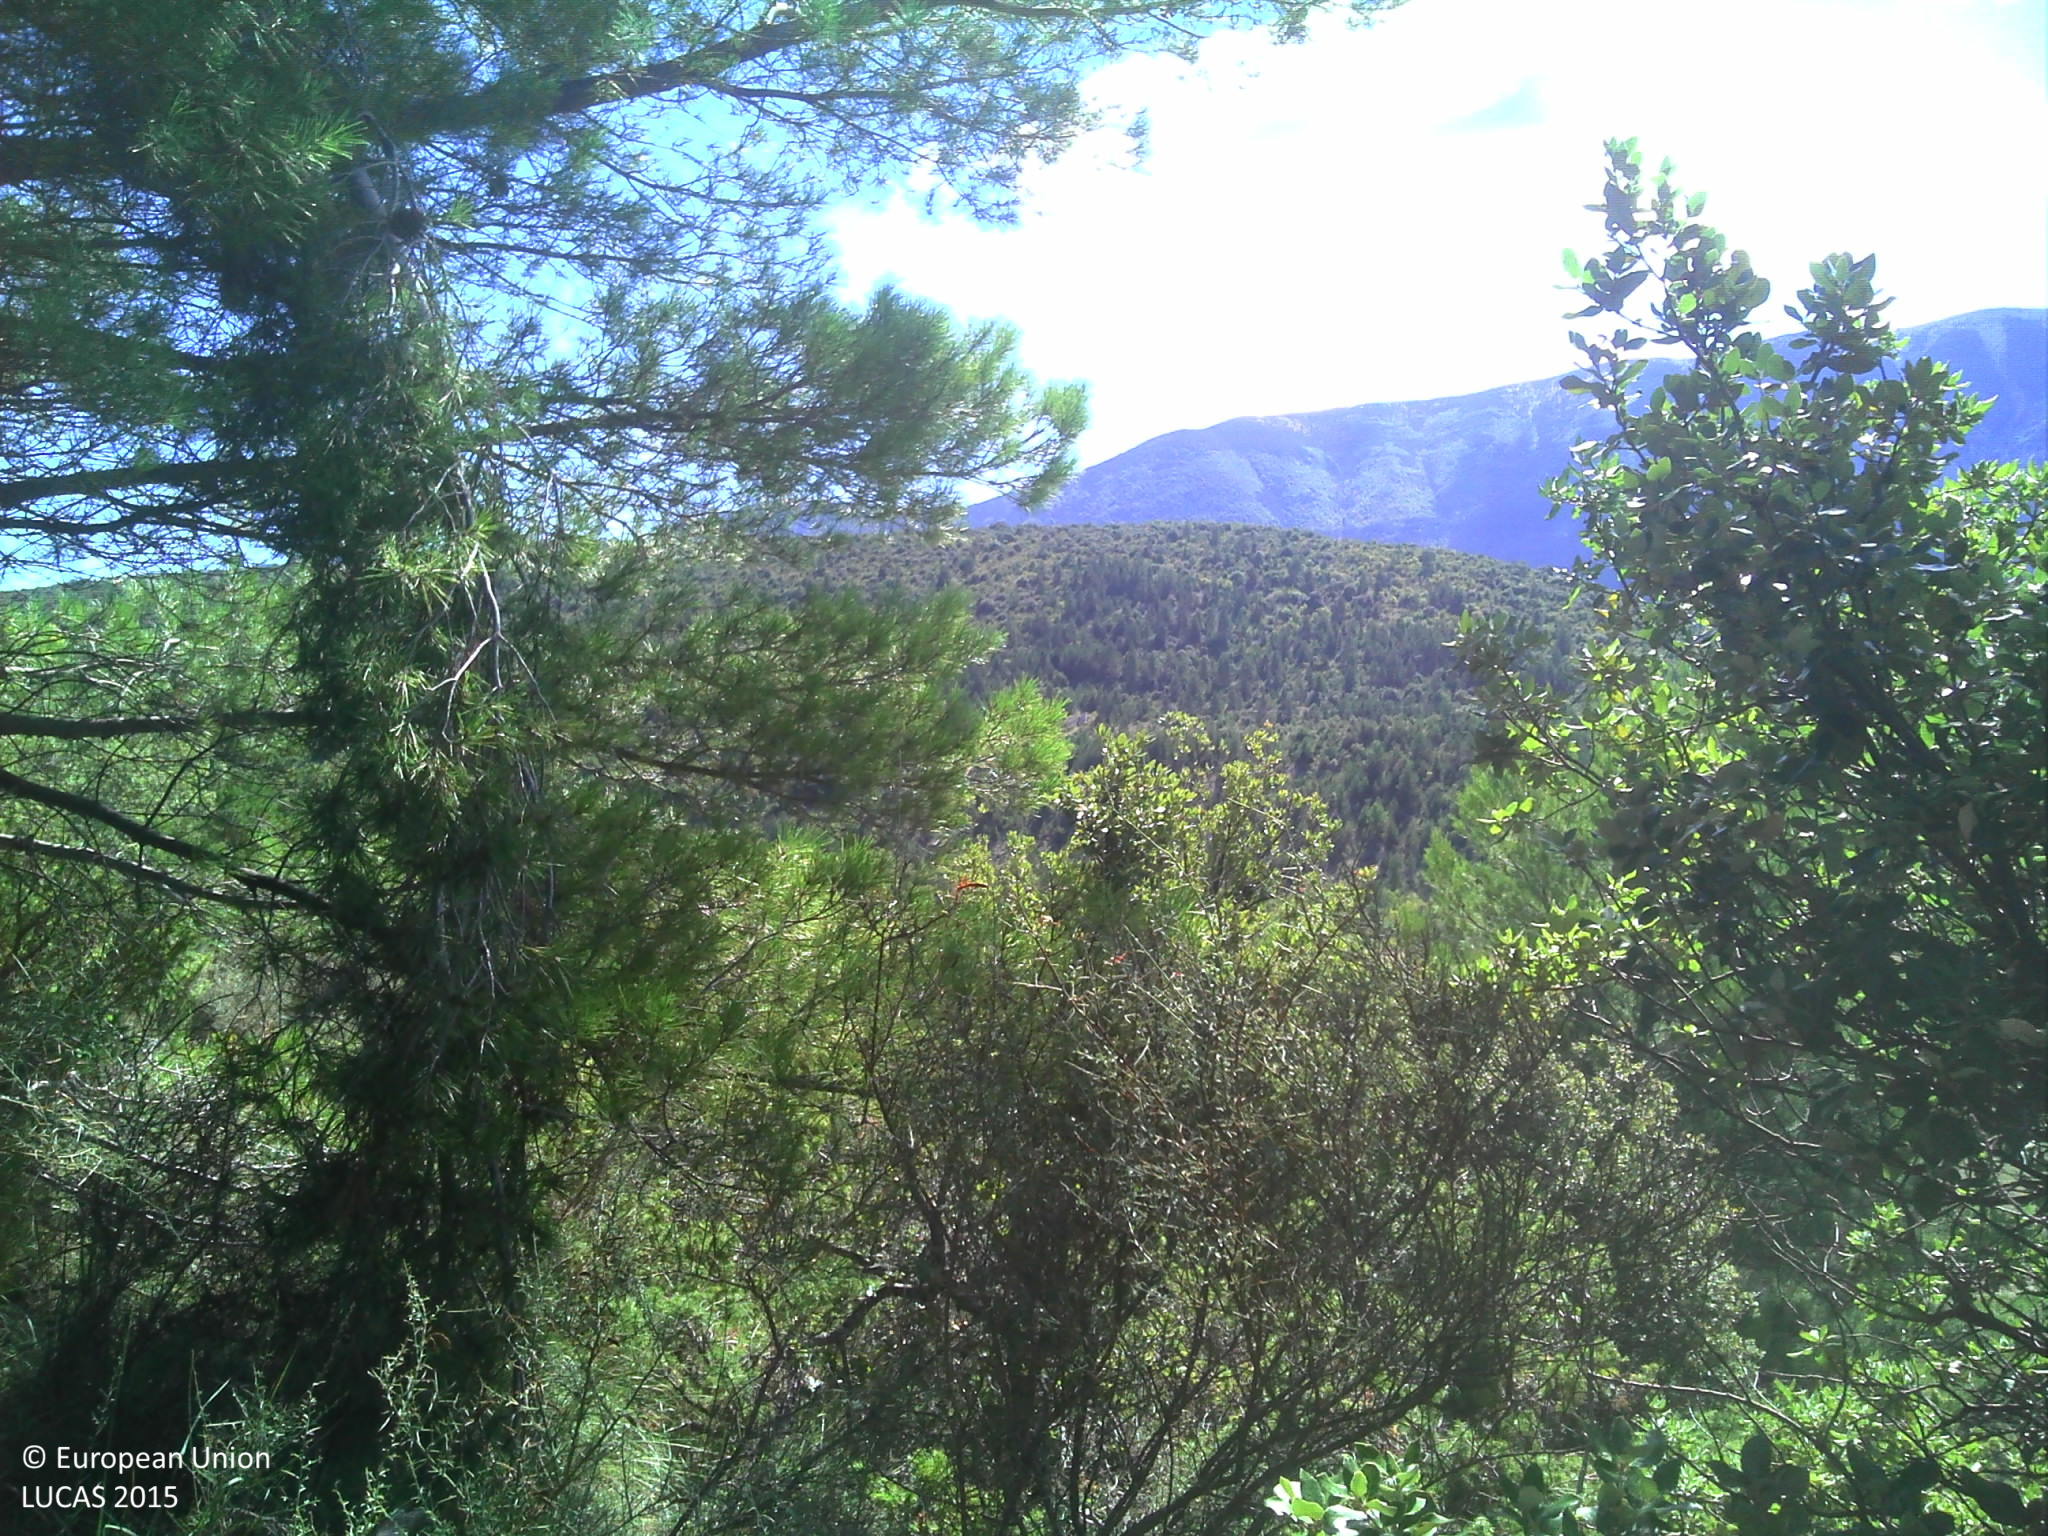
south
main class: Woodland
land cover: Pine dominated mixed woodland
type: coniferous forest of the mediterranean region
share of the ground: 50 - 75 %
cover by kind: shrubs 55 %, broadleaved forest trees 25 %, coniferous forest trees 20 %
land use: Agriculture (excluding fallow land and kitchen gardens)
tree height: < 5 m
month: September
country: FR
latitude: 44.2098
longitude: 5.3397
